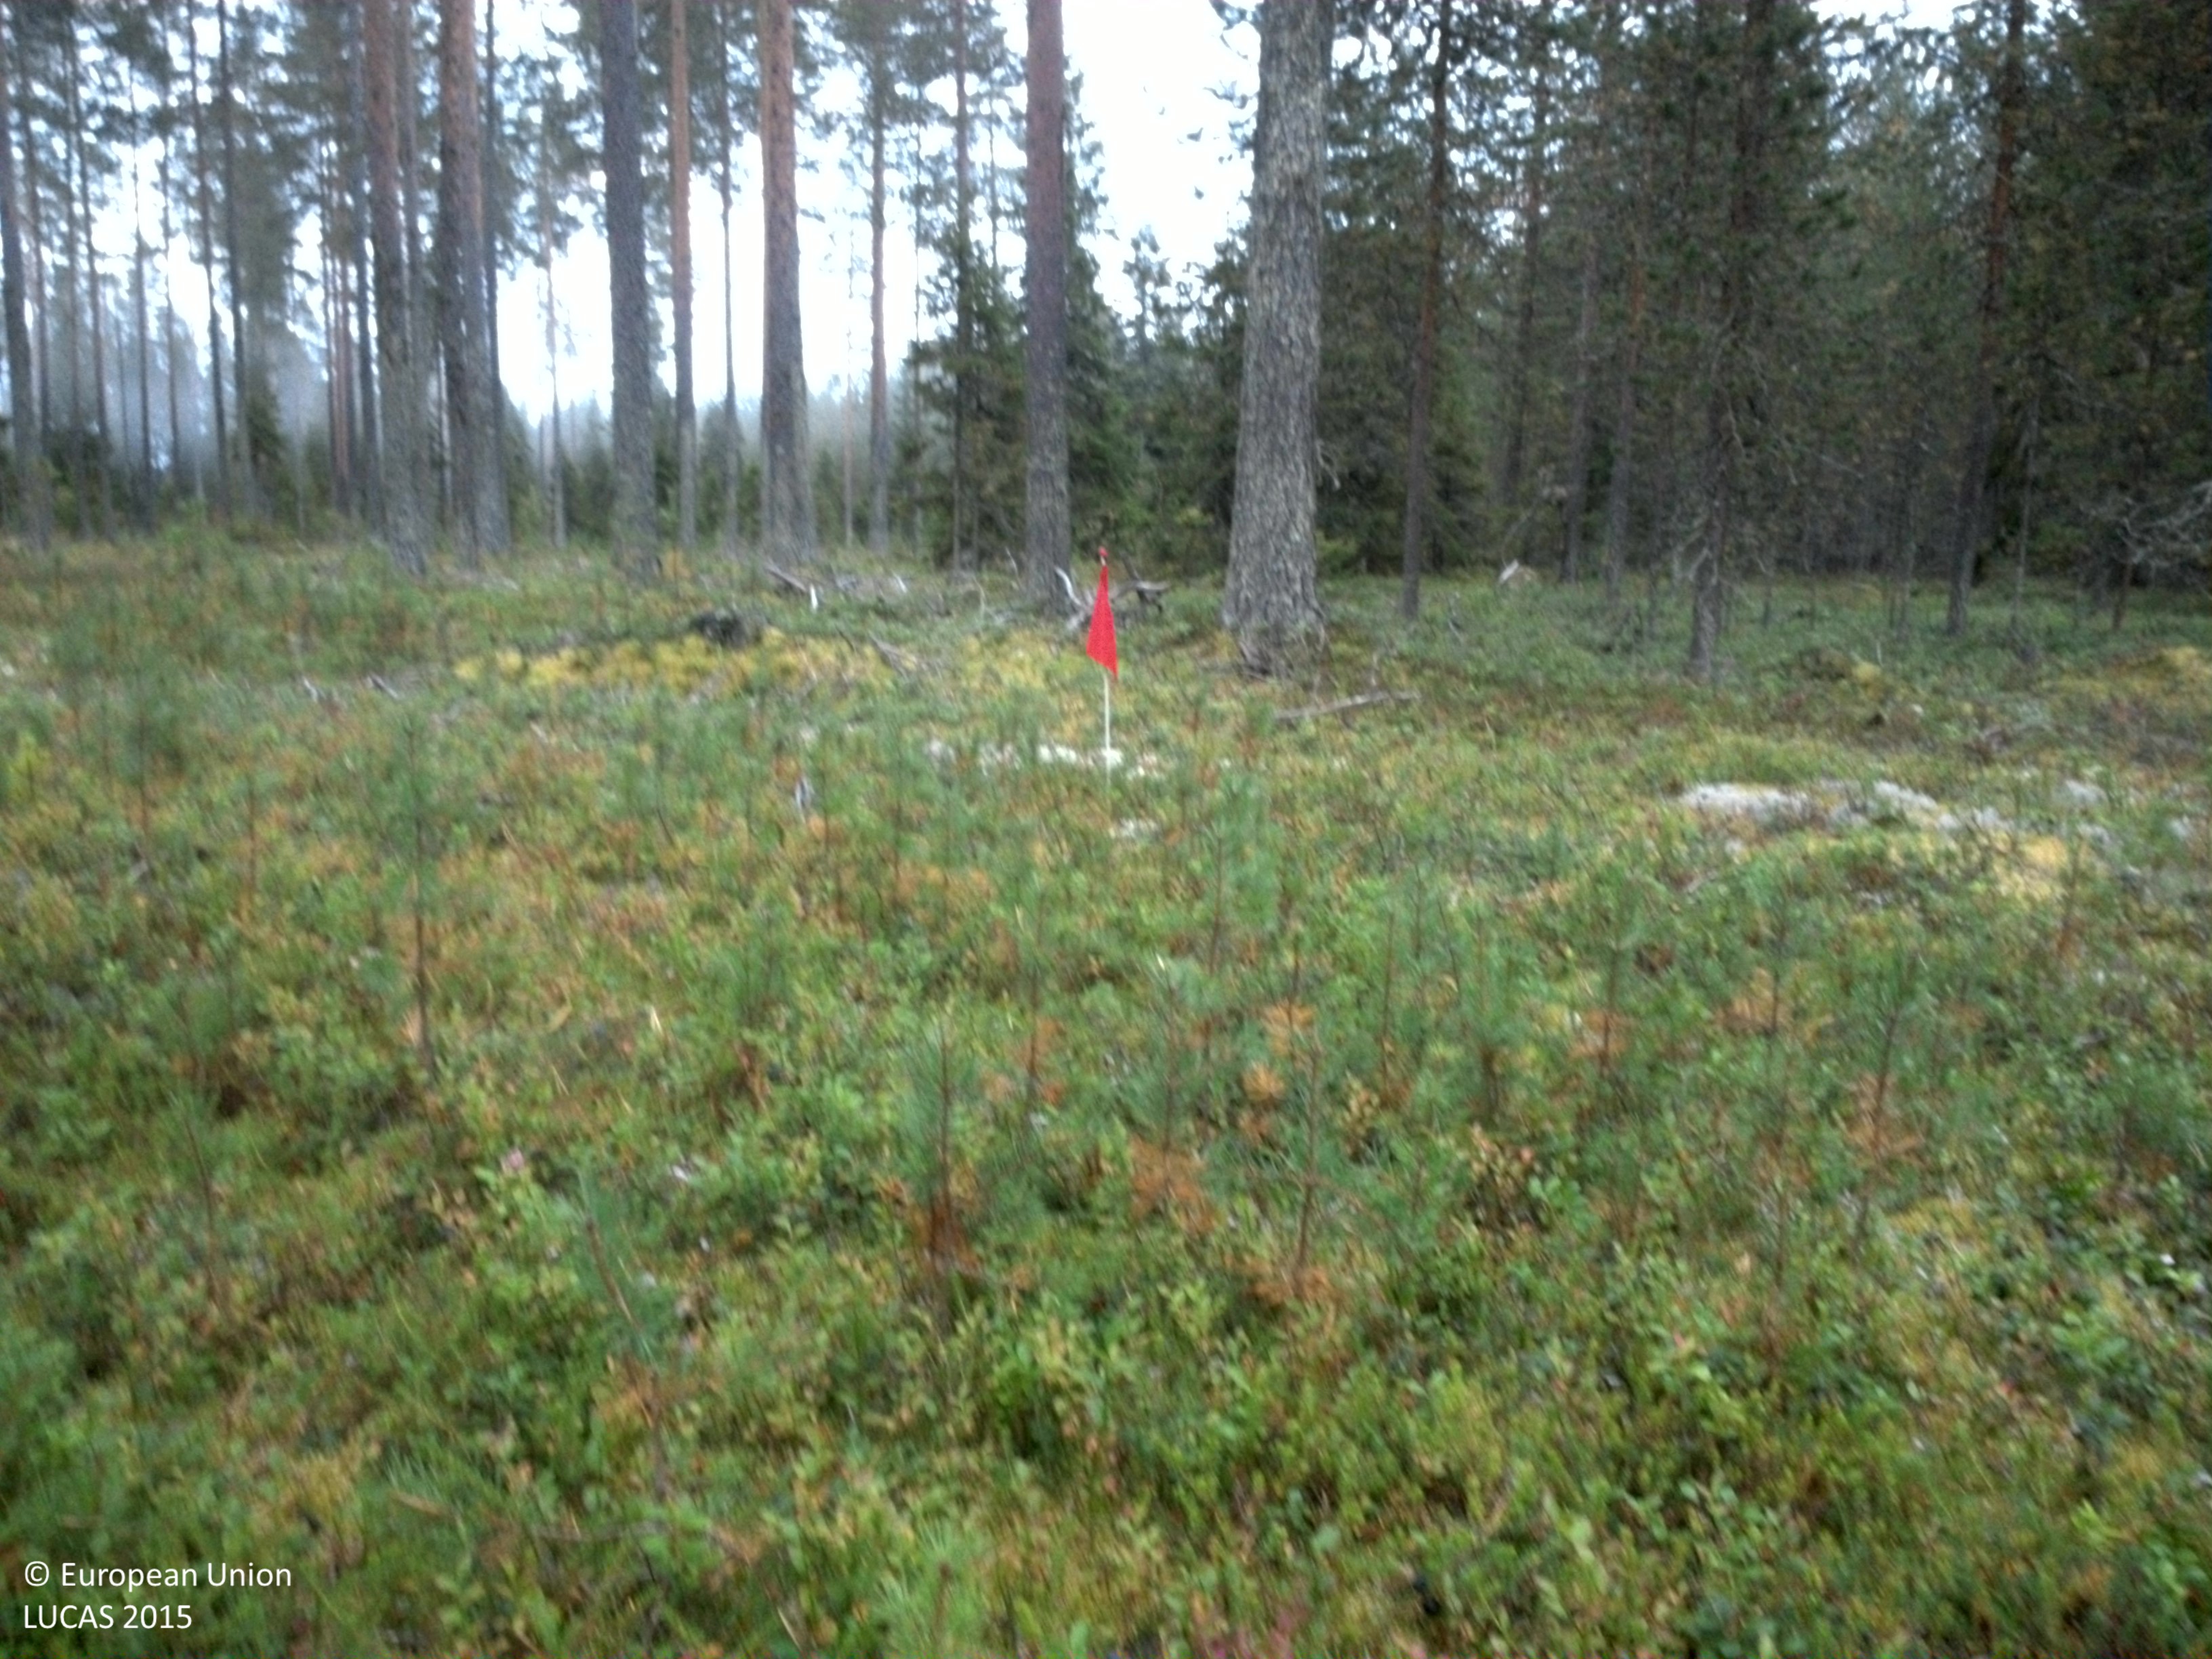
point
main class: Woodland
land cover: Pine dominated coniferous woodland
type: boreal forest
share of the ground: 25 - 50 %
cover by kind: shrubs 60 %, coniferous forest trees 30 %, lichens and mosses 10 %
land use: Forestry
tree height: > 5 m
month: September
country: SE
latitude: 65.5683
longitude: 22.0477
